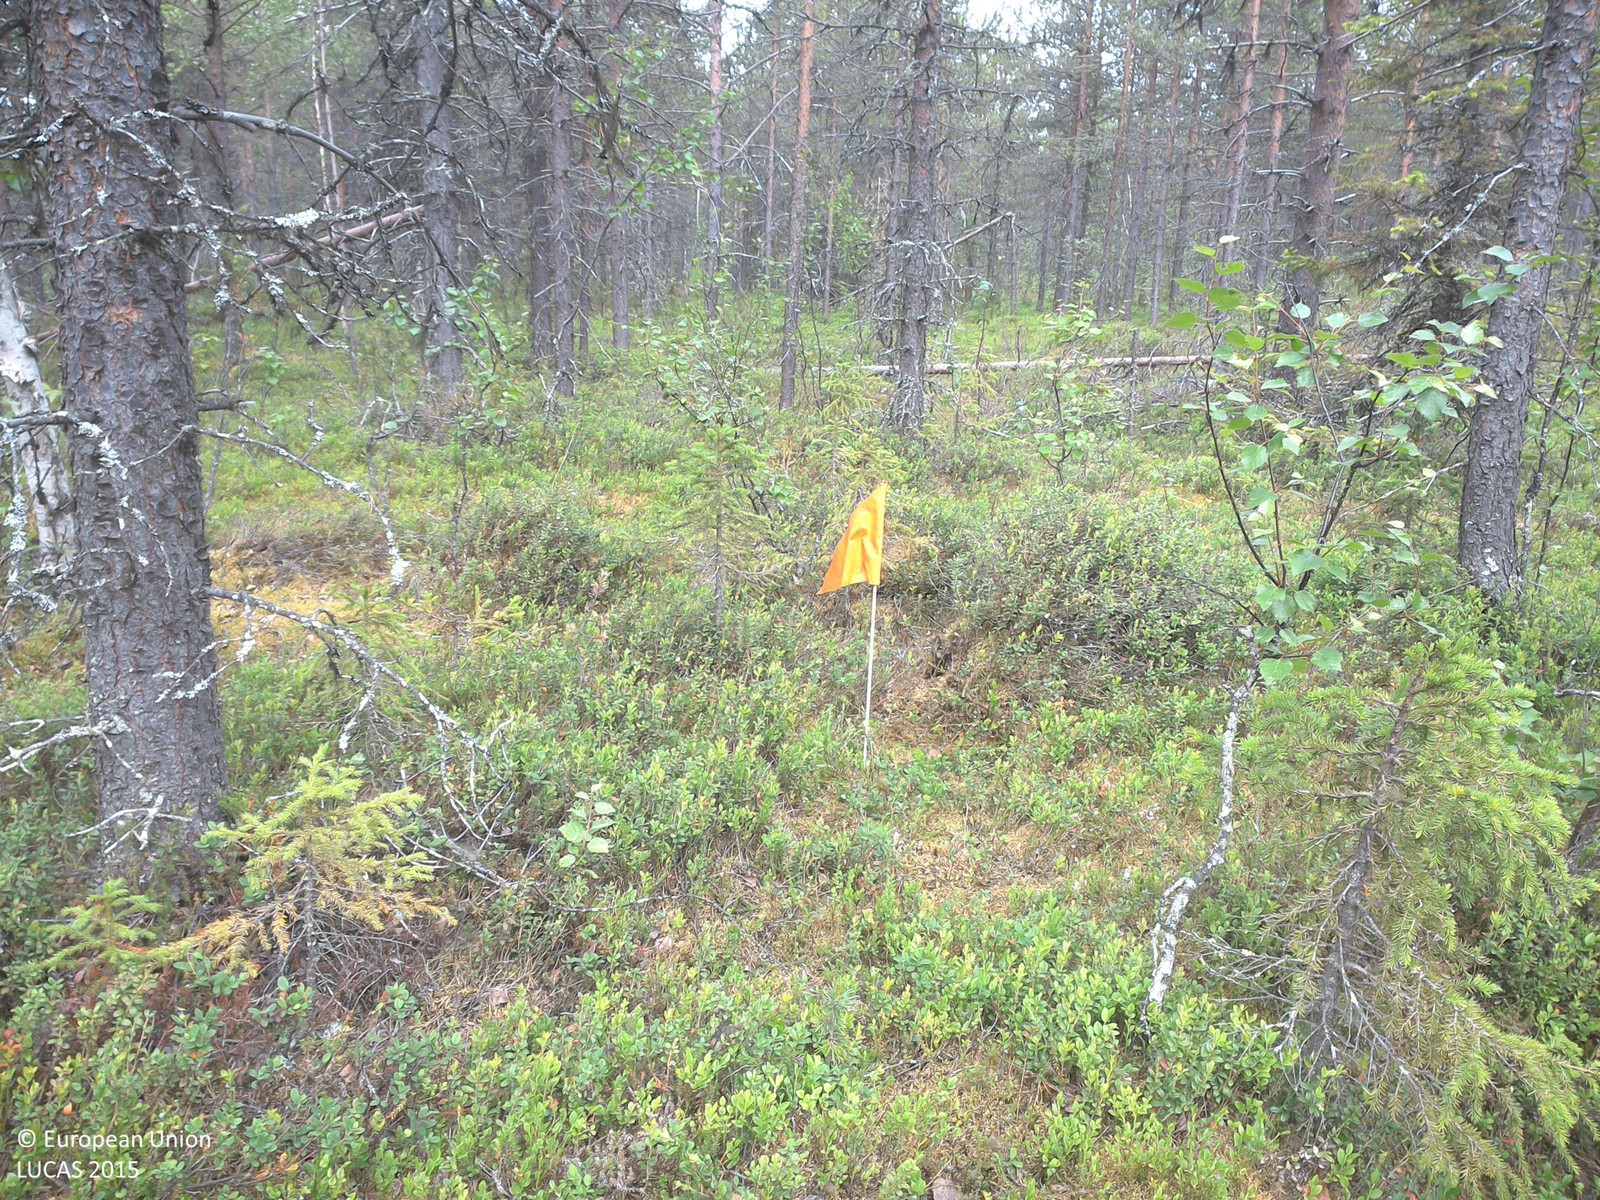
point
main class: Woodland
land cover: Pine dominated coniferous woodland
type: boreal forest
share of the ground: 25 - 50 %
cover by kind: shrubs 50 %, coniferous forest trees 40 %, lichens and mosses 10 %
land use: Forestry
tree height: > 5 m
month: July
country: SE
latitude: 67.5781
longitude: 22.7159
